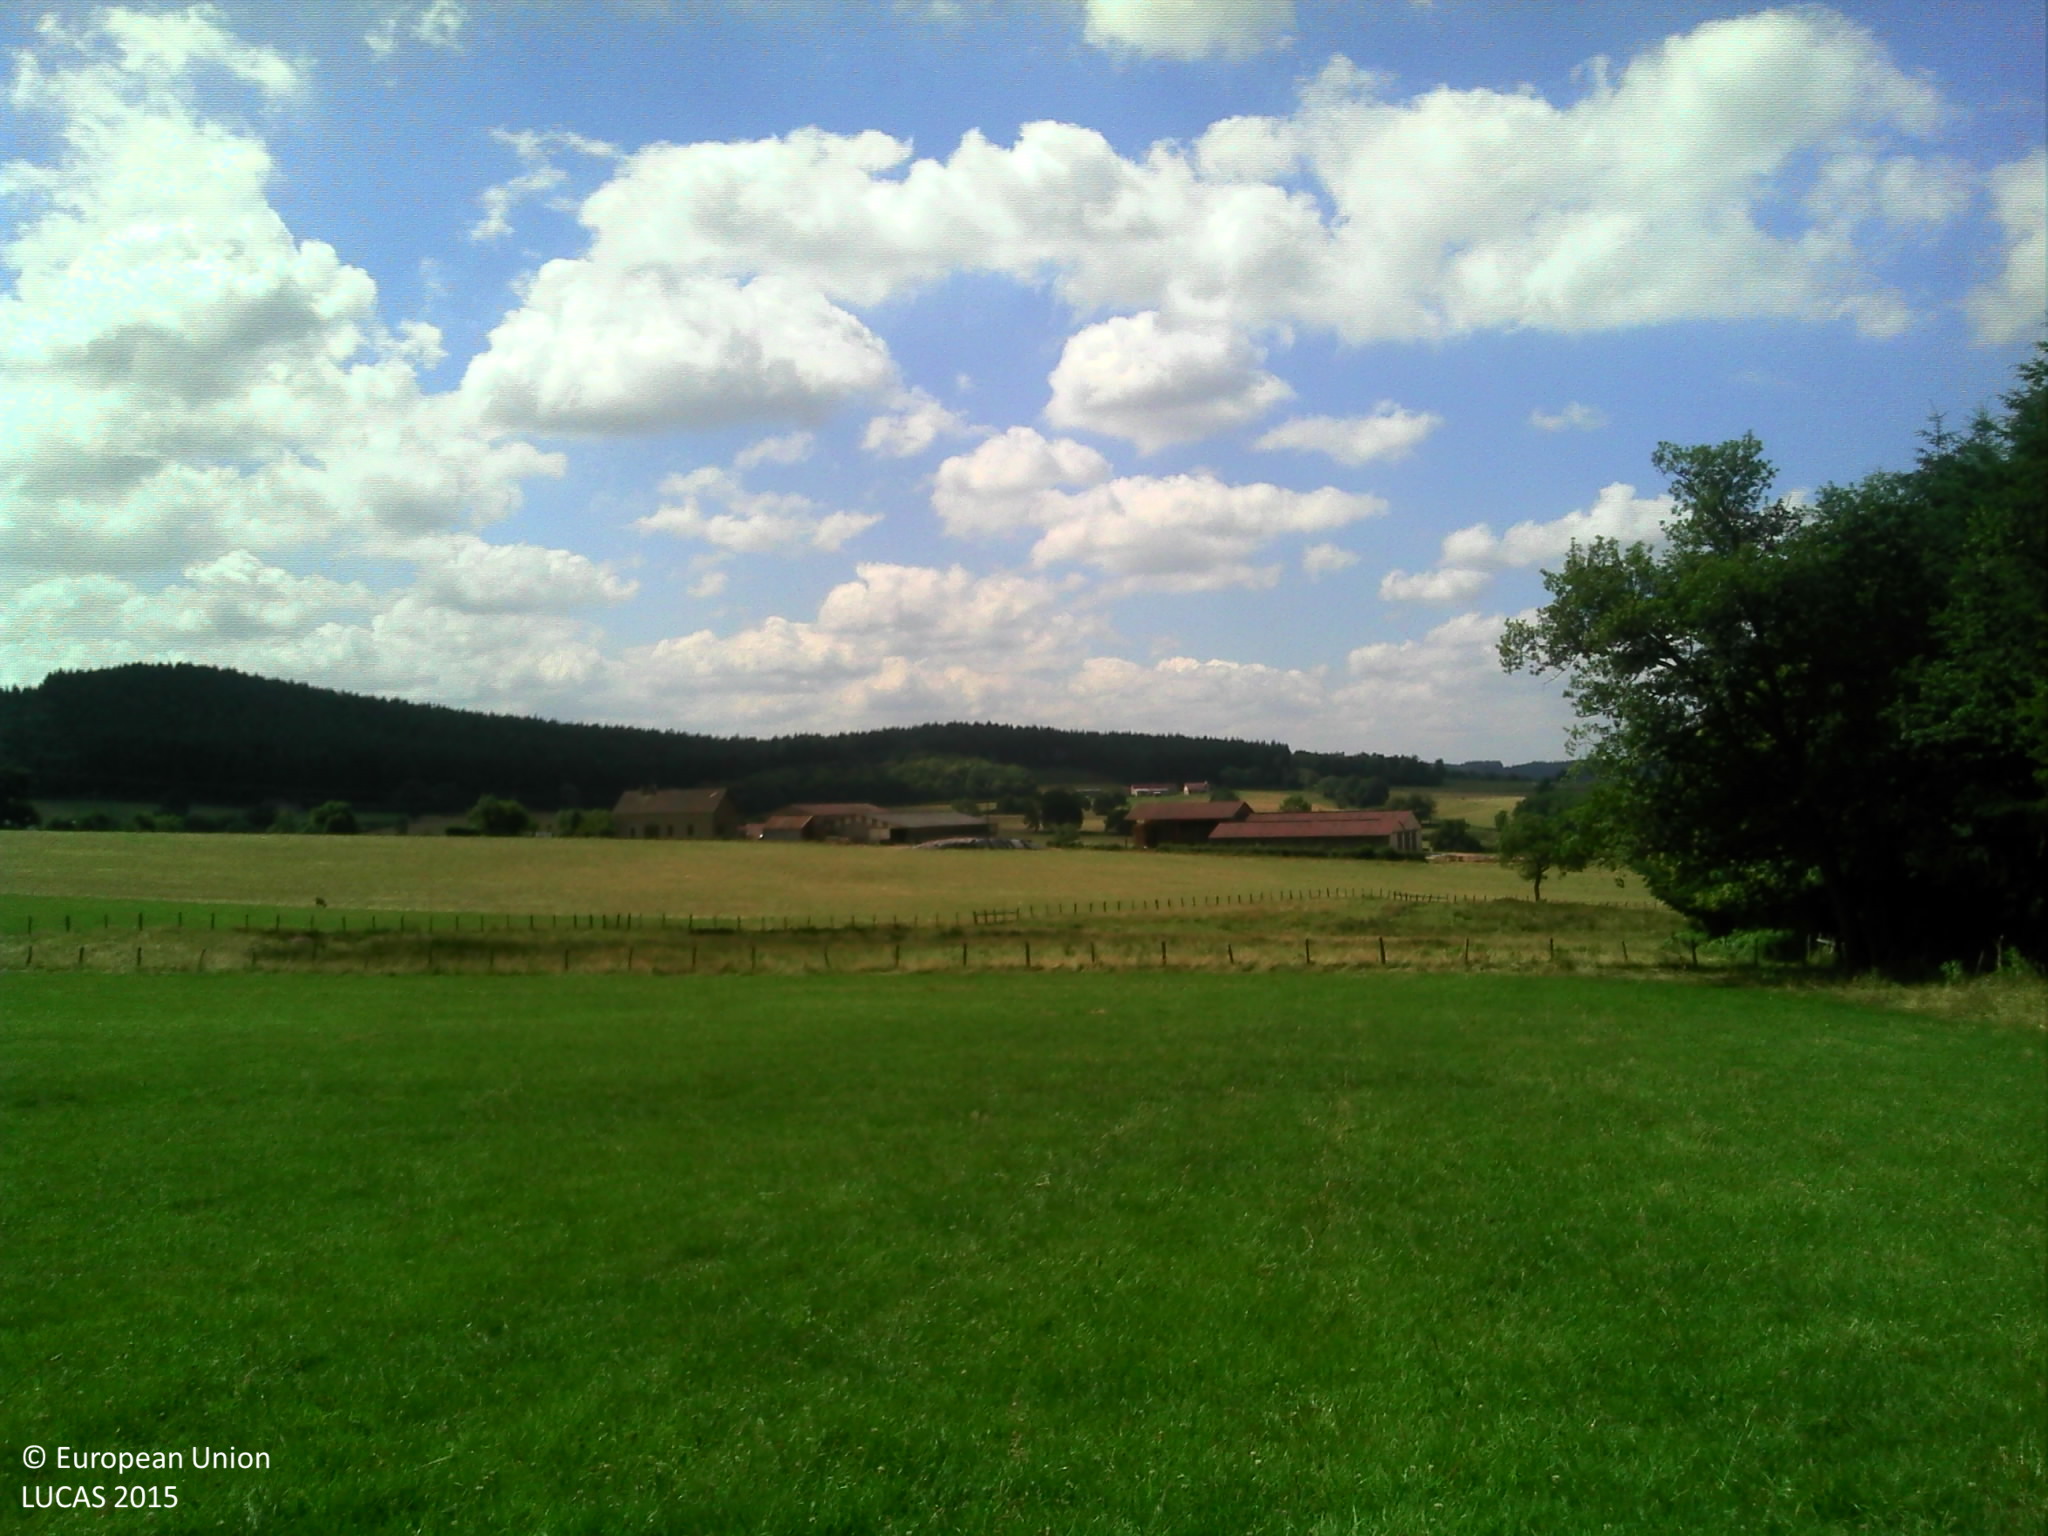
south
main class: Cropland
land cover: Temporary grasslands
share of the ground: > 75 %
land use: Agriculture (excluding fallow land and kitchen gardens)
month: June
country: FR
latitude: 46.4415
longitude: 4.4434
